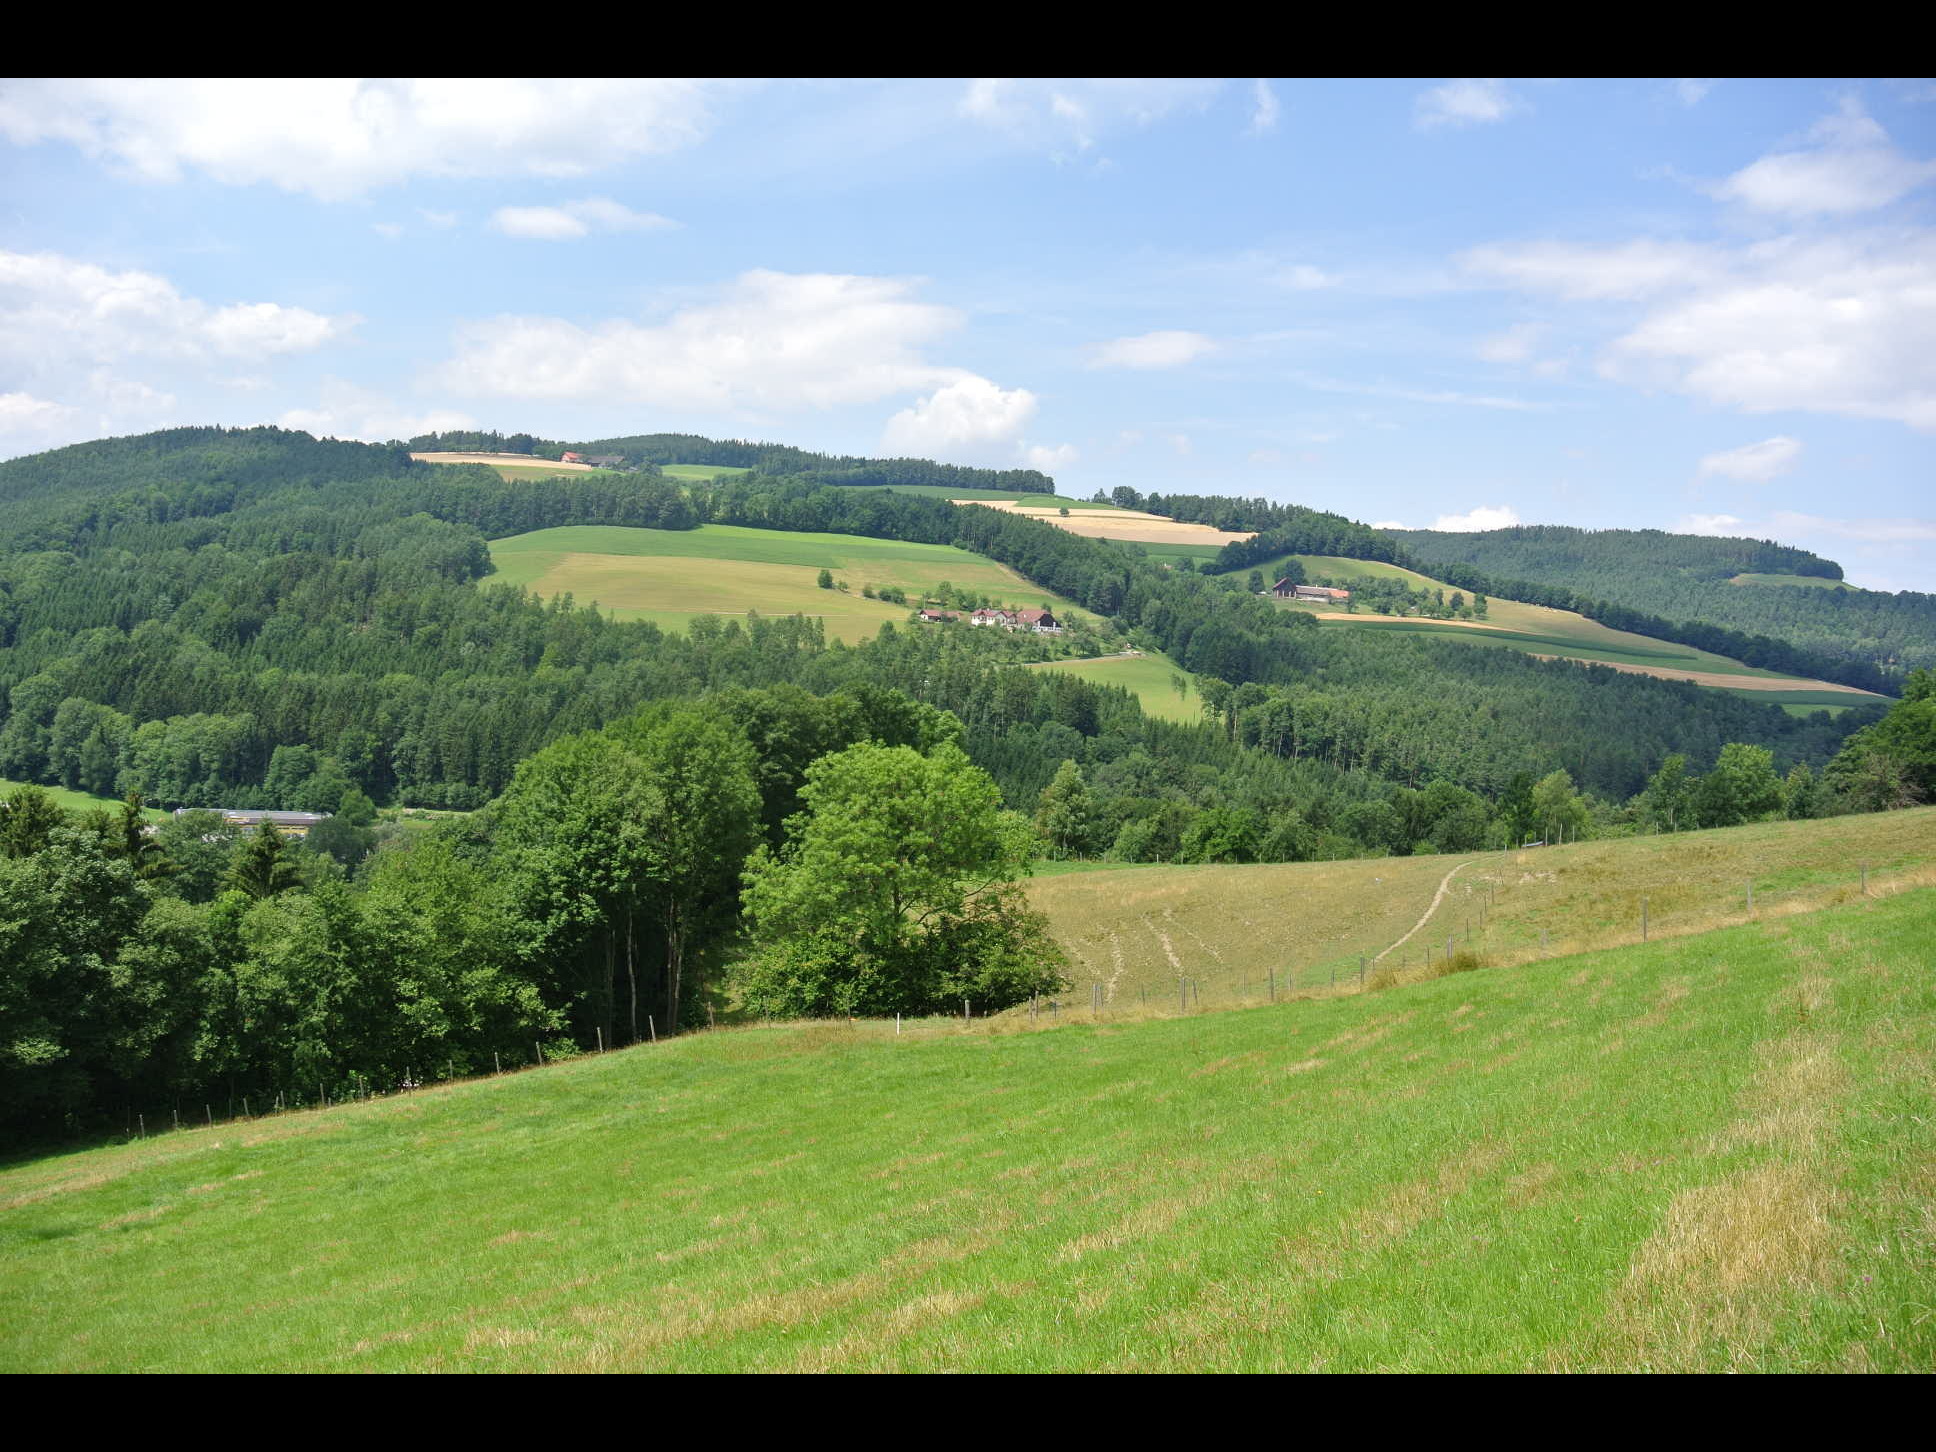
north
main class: Grassland
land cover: Grassland without tree/shrub cover
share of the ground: > 75 %
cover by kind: herbaceous plants 100 %
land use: Agriculture (excluding fallow land and kitchen gardens)
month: July
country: AT
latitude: 47.5851
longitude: 16.1059
